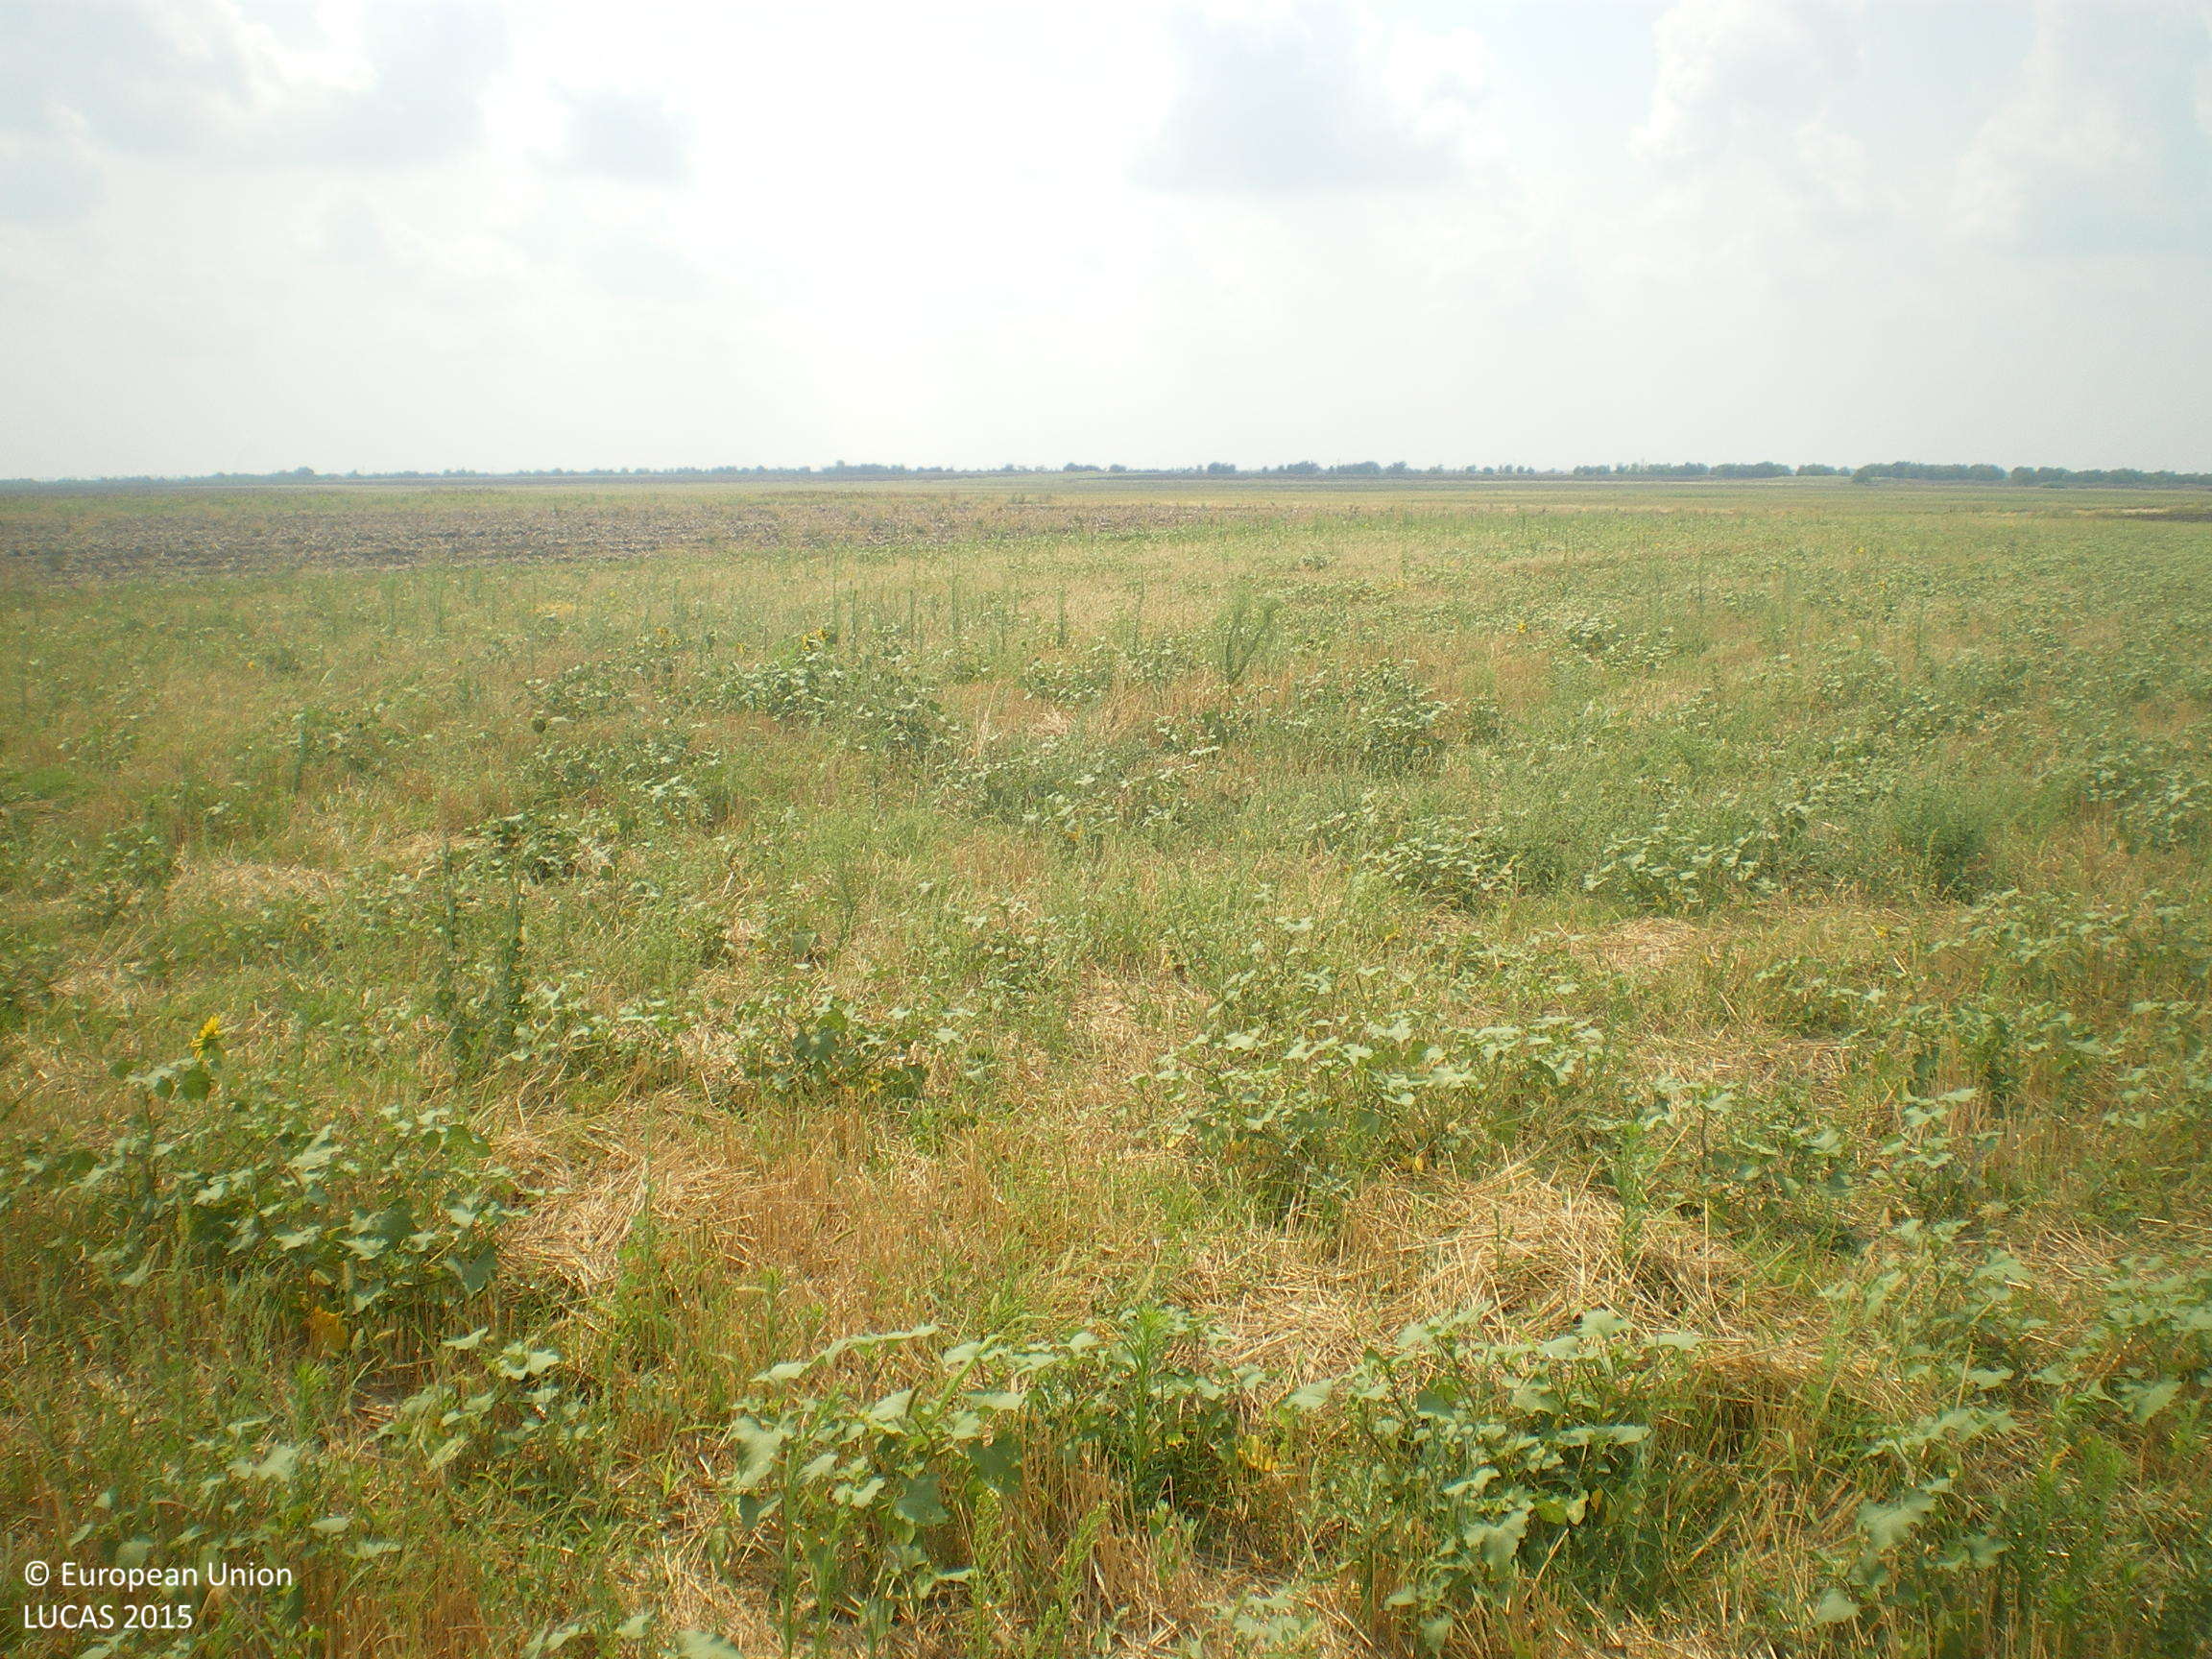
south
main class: Cropland
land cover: Common wheat
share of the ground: < 10 %
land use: Agriculture (excluding fallow land and kitchen gardens)
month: August
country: BG
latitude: 42.3488
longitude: 25.8693
